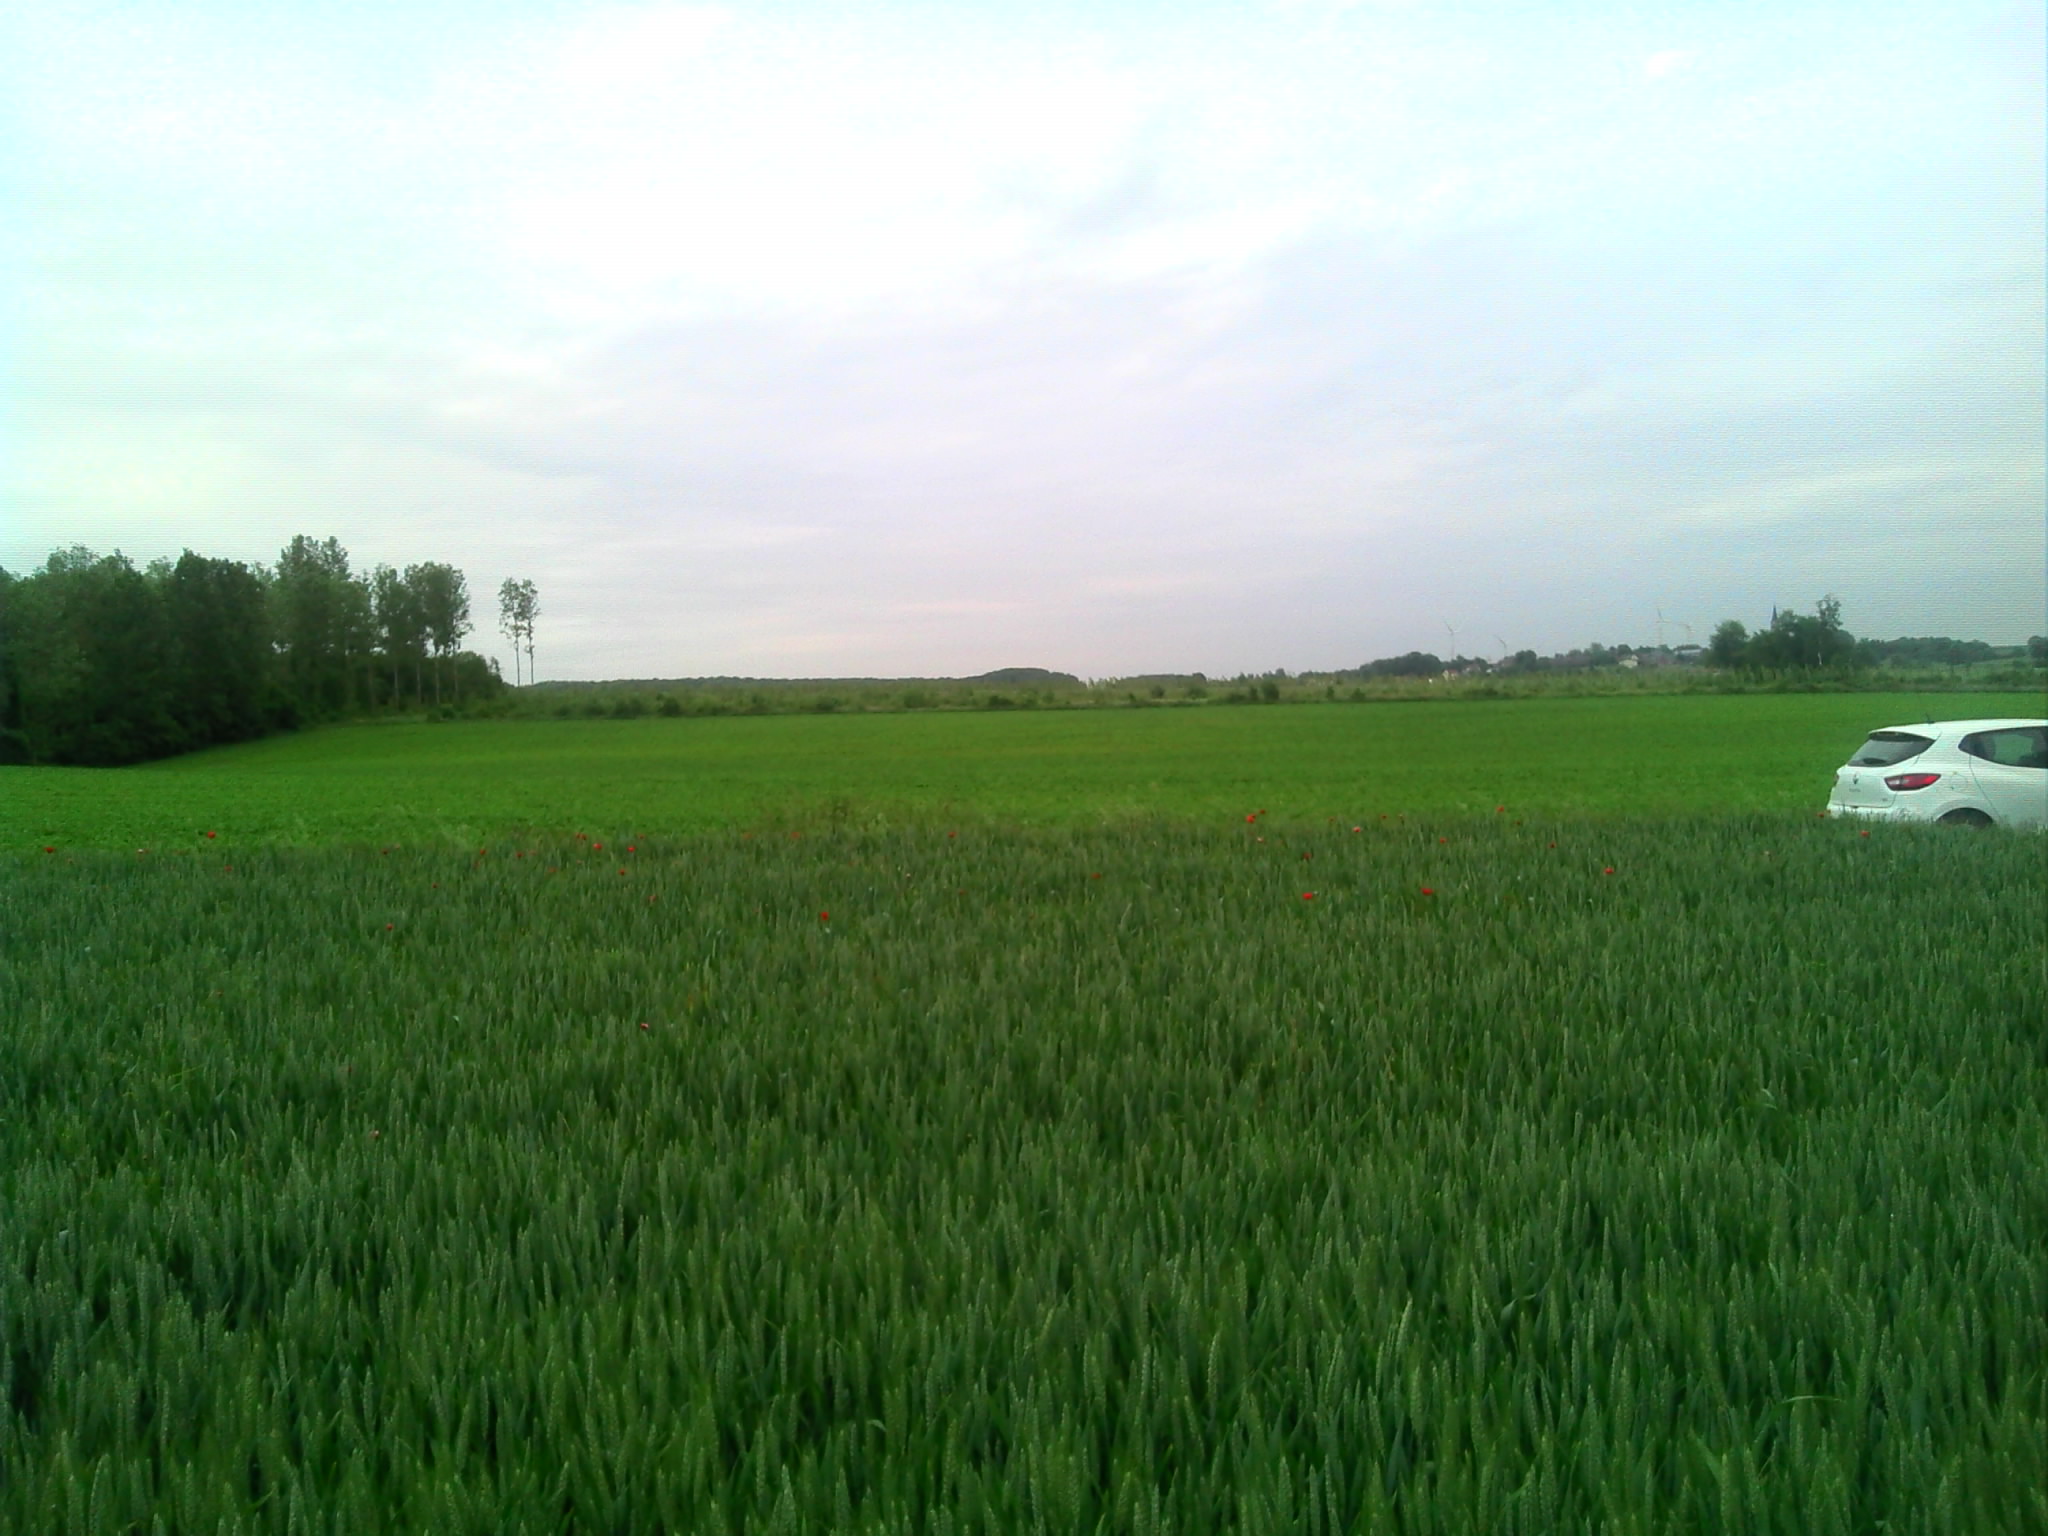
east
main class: Cropland
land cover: Common wheat
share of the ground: > 75 %
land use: Agriculture (excluding fallow land and kitchen gardens)
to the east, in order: Common wheat; Grass margins; Tracks; Grass margins; Sugar beet
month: June
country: FR
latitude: 49.7144
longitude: 3.2653
